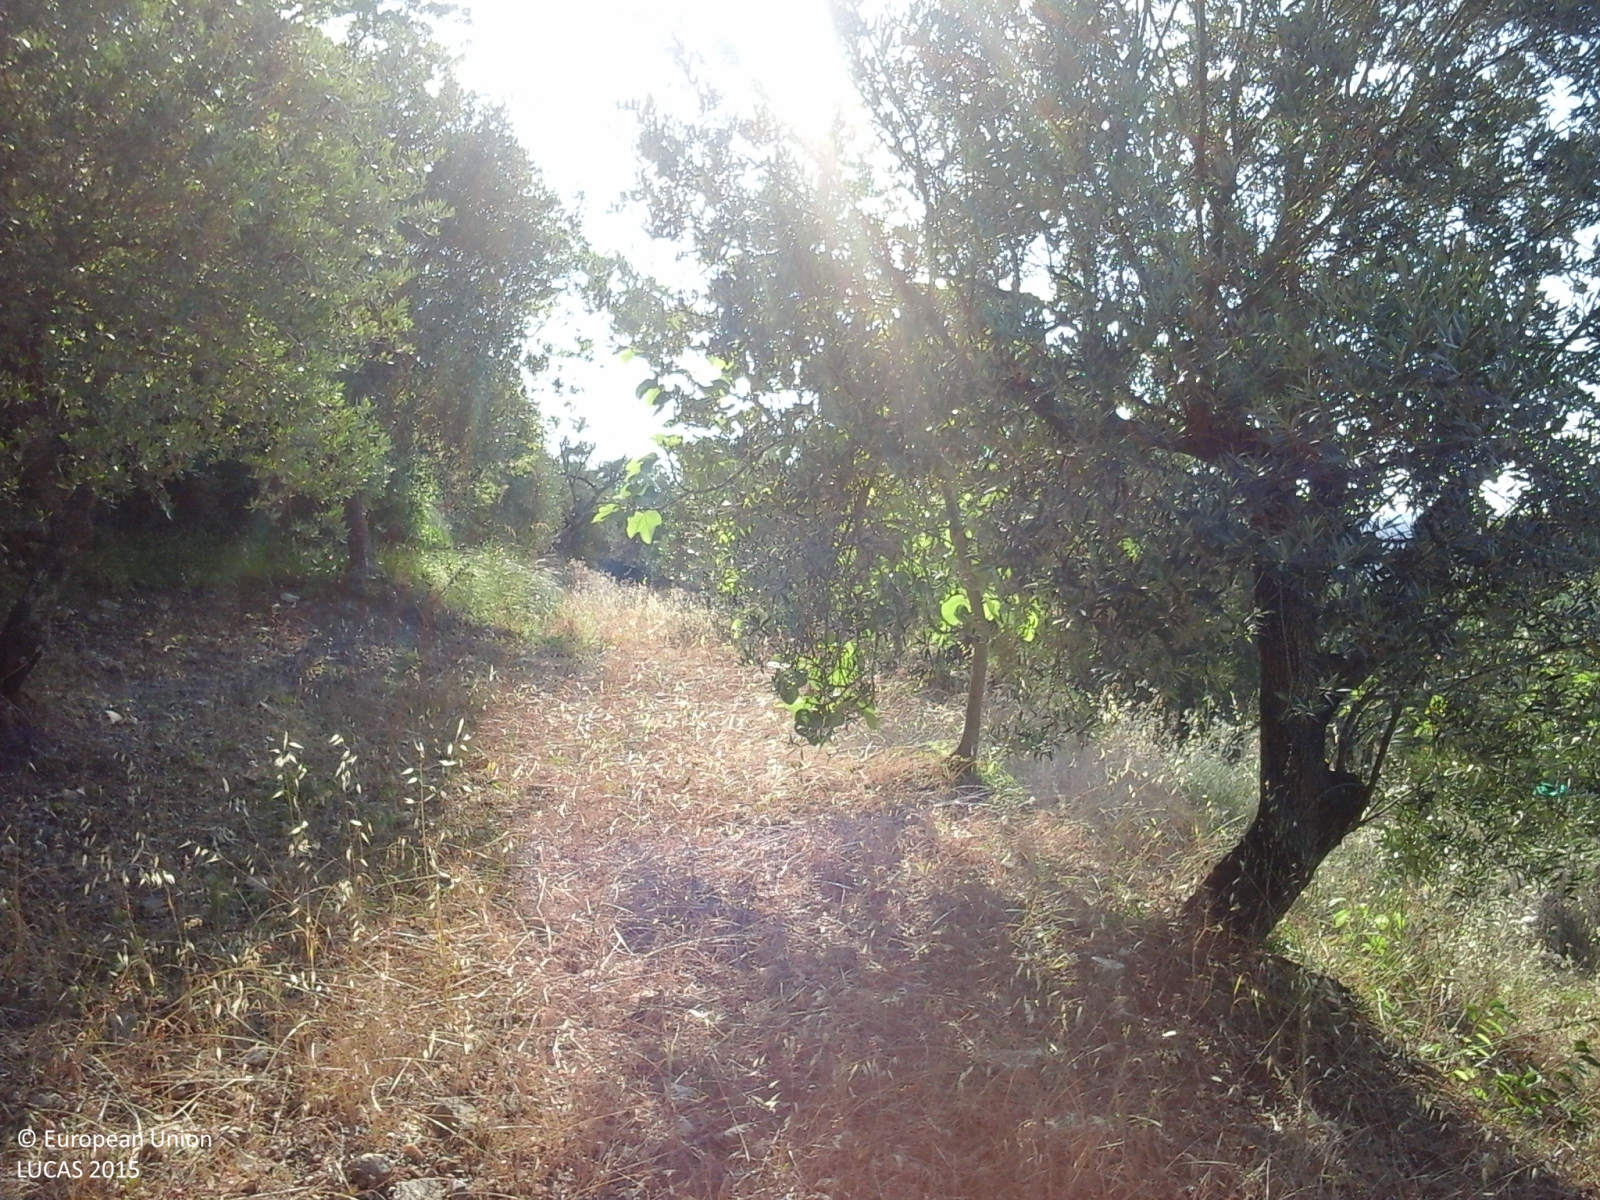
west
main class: Cropland
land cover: Olive groves
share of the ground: 50 - 75 %
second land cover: Other fruit trees and berries
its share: 10 - 25 %
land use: Agriculture (excluding fallow land and kitchen gardens)
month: June
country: IT
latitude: 40.2114
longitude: 15.0180
